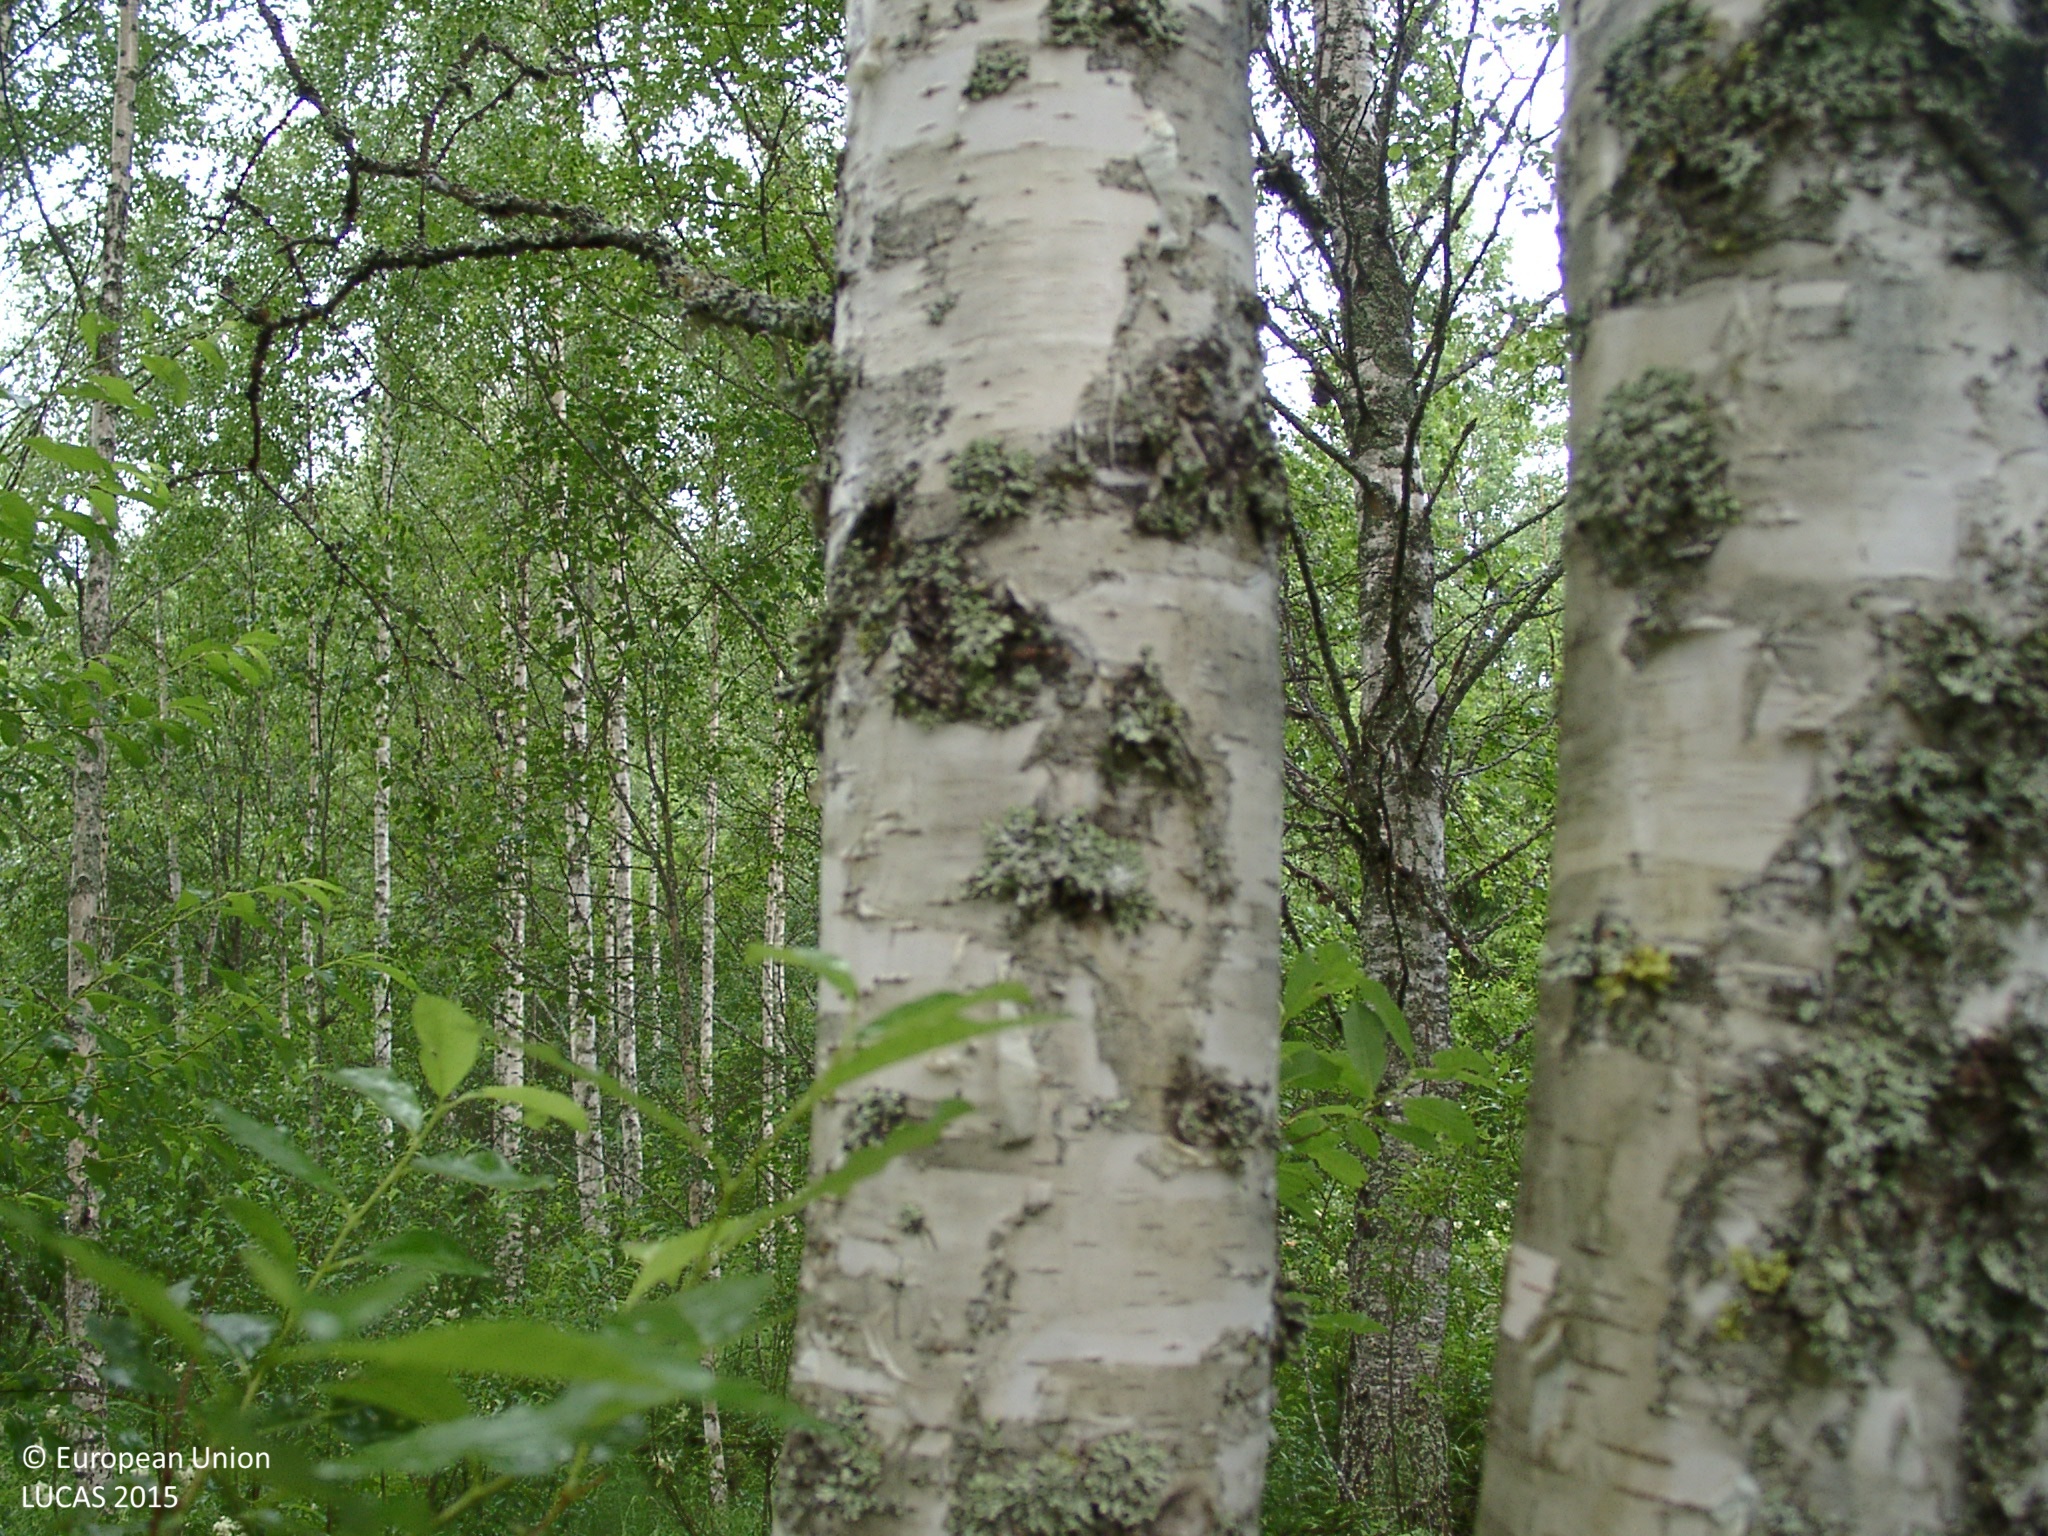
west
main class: Woodland
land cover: Broadleaved woodland
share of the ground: 50 - 75 %
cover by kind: broadleaved forest trees 60 %, herbaceous plants 30 %, shrubs 10 %
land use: Semi-natural and natural areas not in use
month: July
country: FI
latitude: 62.2512
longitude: 25.6152
